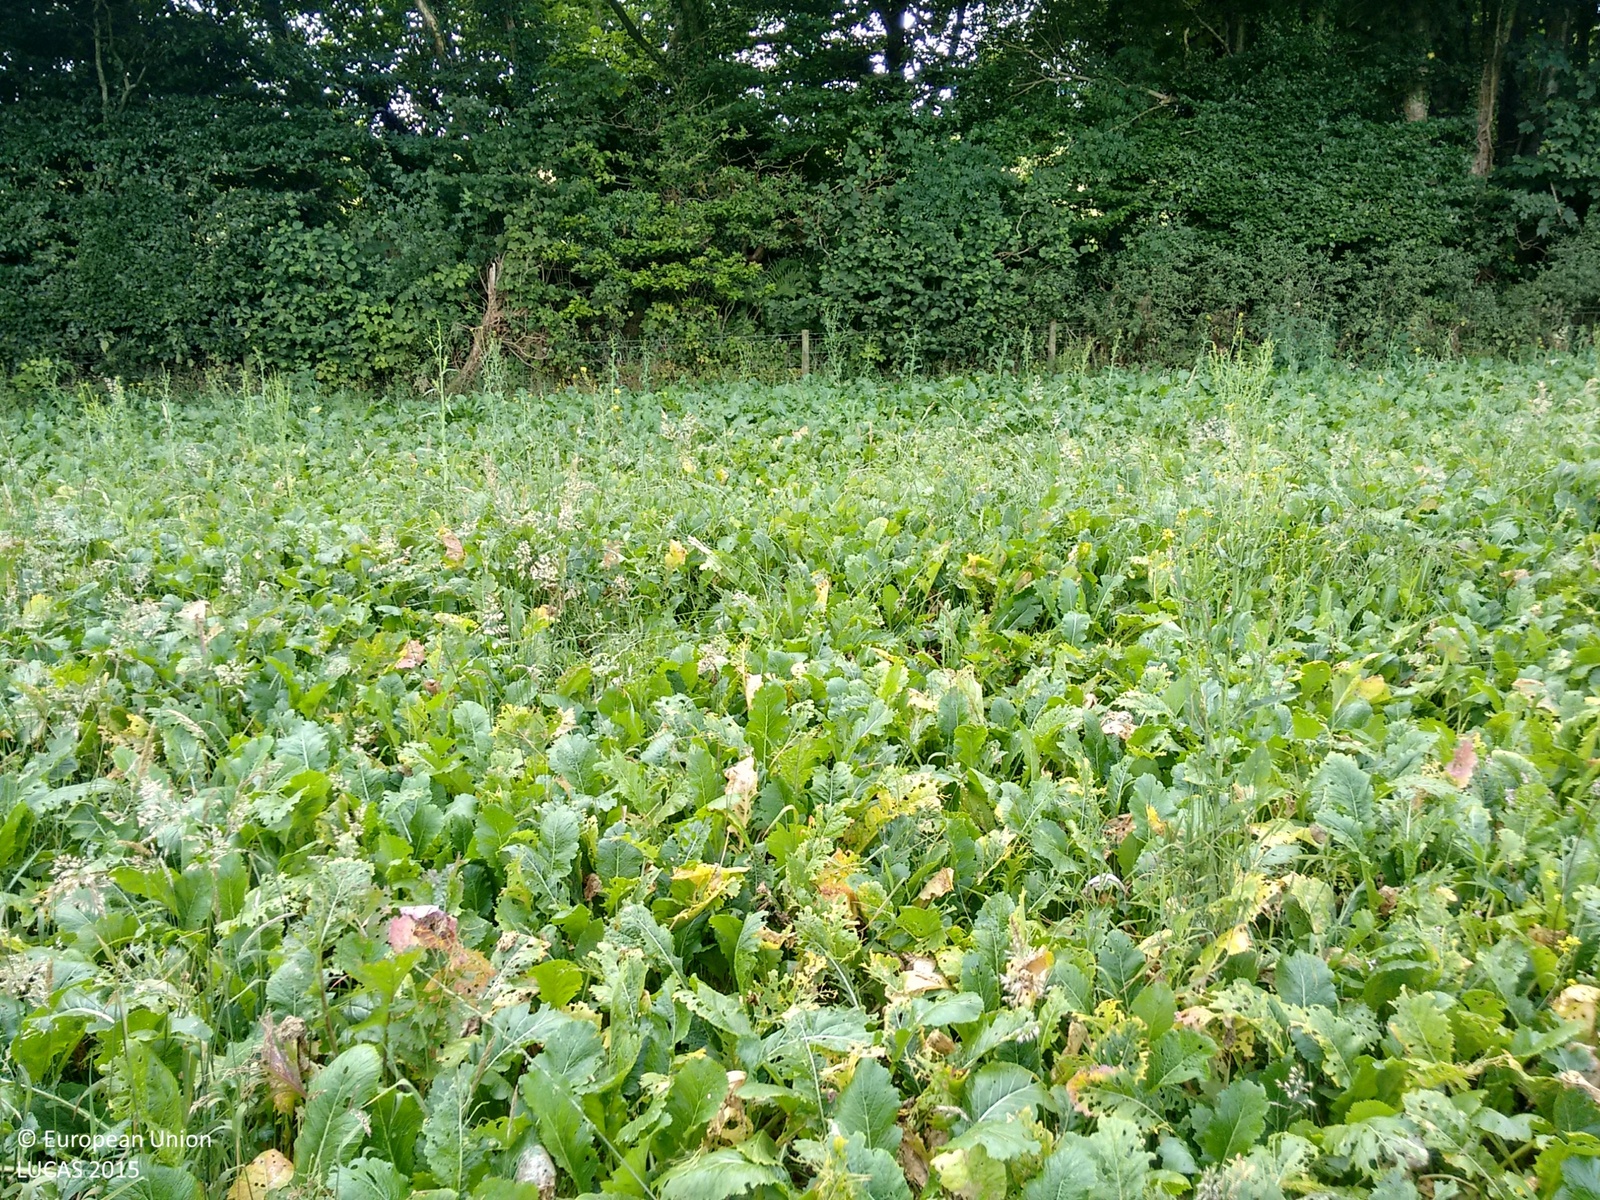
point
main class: Cropland
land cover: Other leguminous and mixtures for fodder
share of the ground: > 75 %
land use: Agriculture (excluding fallow land and kitchen gardens)
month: August
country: GB
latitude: 50.9201
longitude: -3.5565
